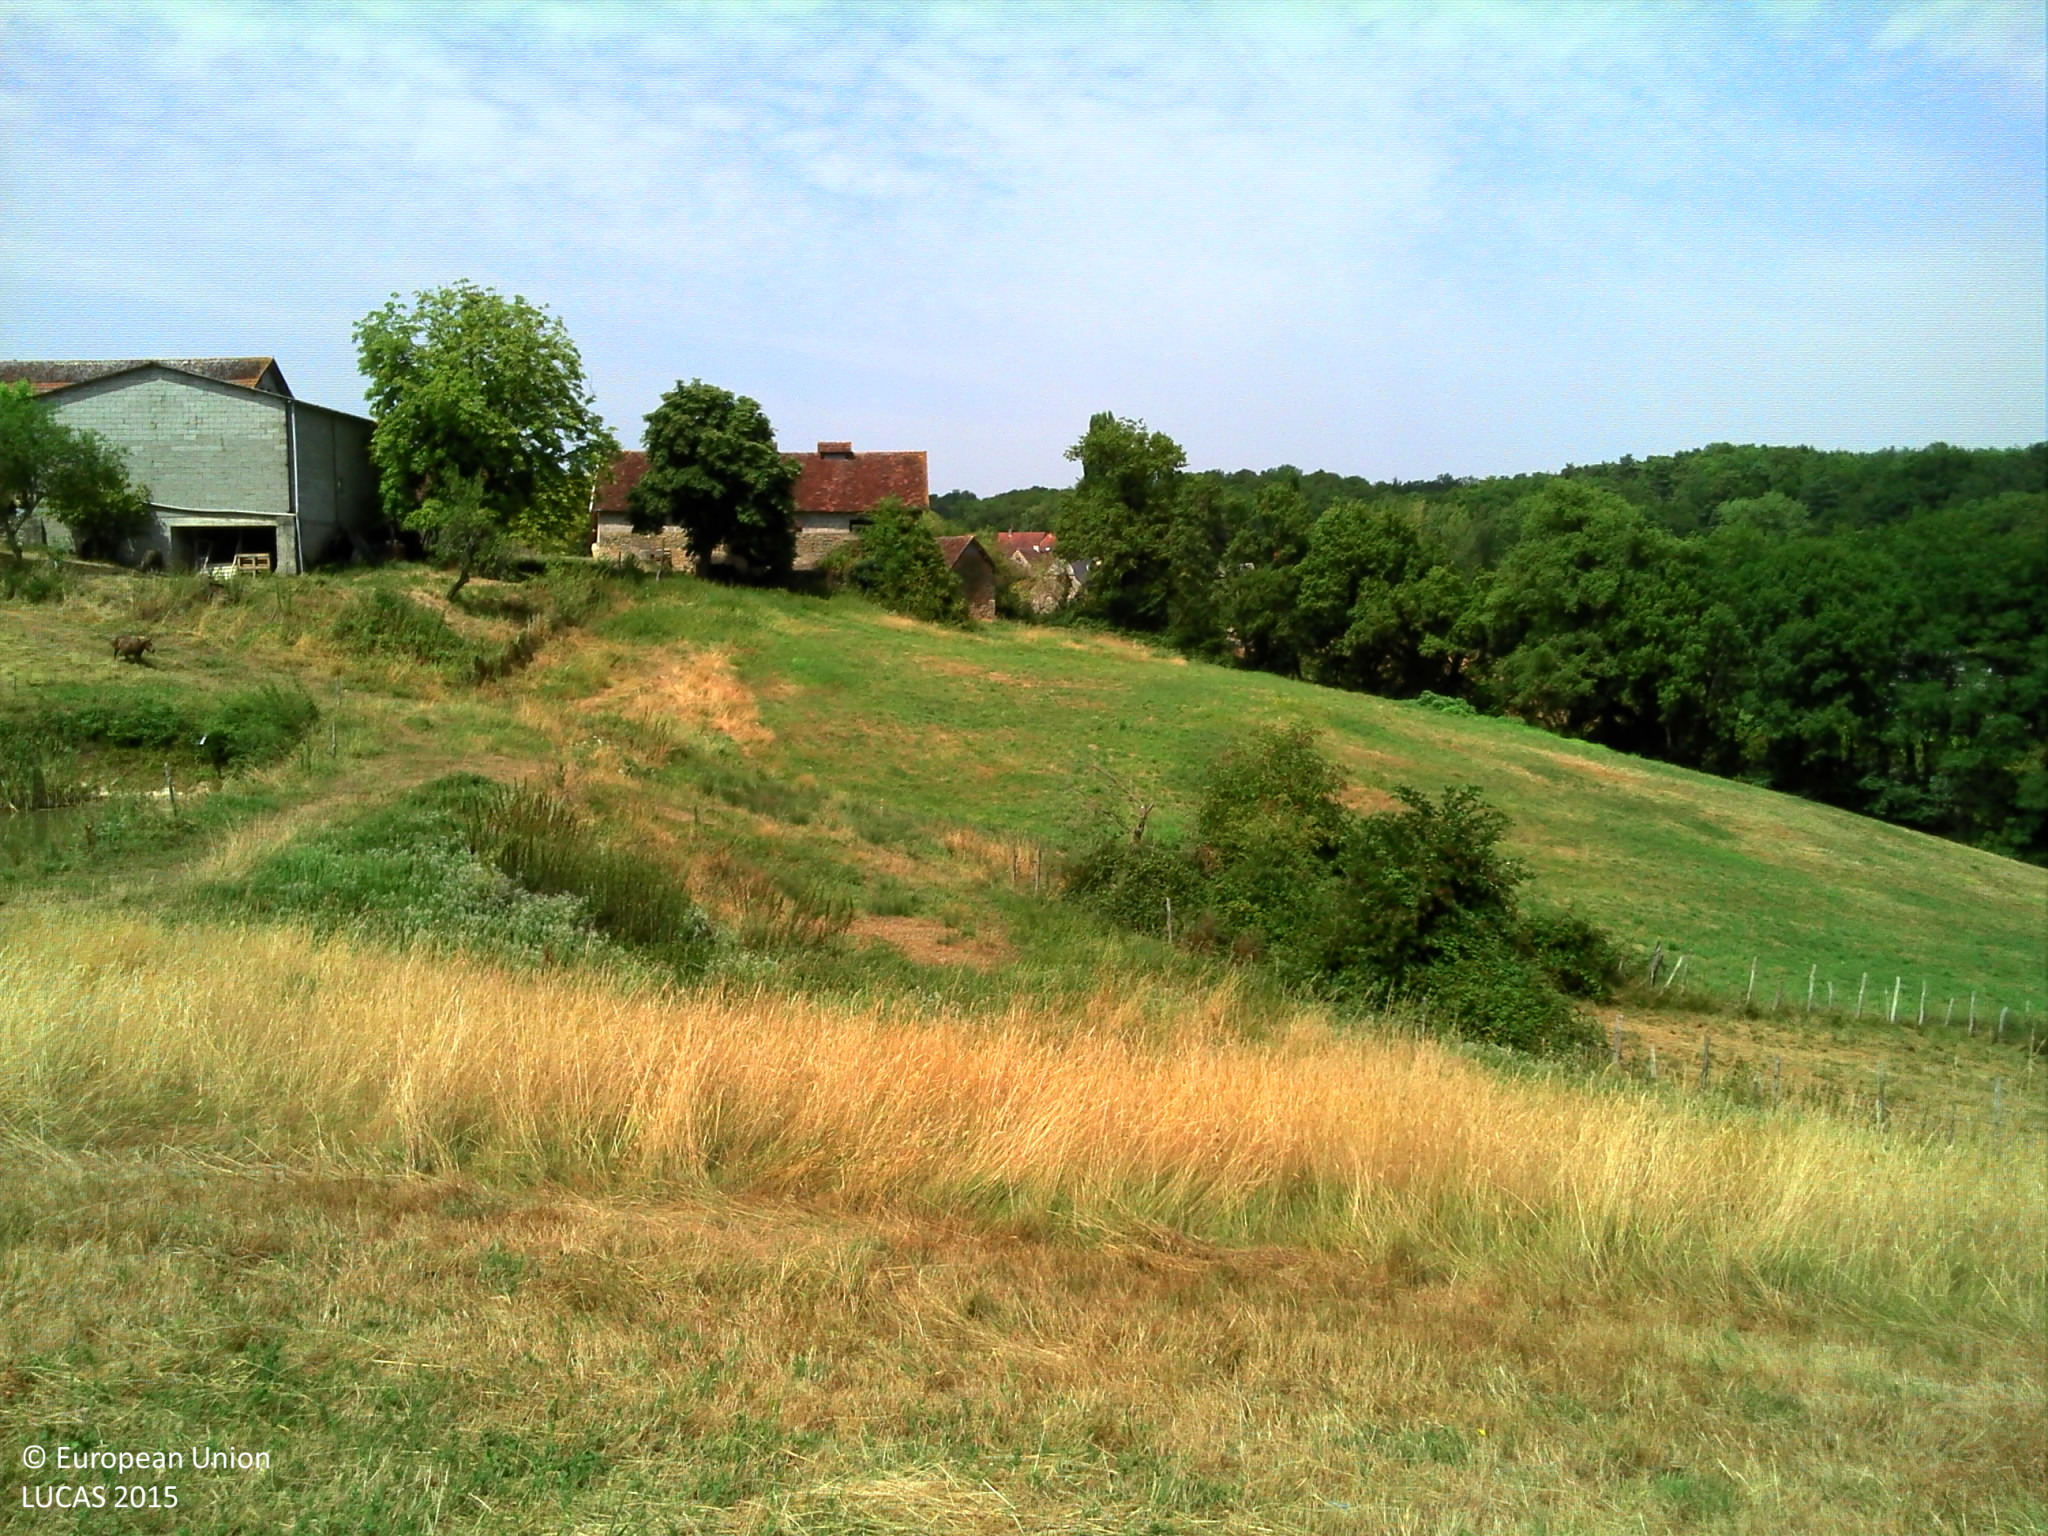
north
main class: Grassland
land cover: Grassland without tree/shrub cover
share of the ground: > 75 %
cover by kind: herbaceous plants 100 %
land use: Agriculture (excluding fallow land and kitchen gardens)
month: July
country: FR
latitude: 45.1863
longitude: 1.1476
